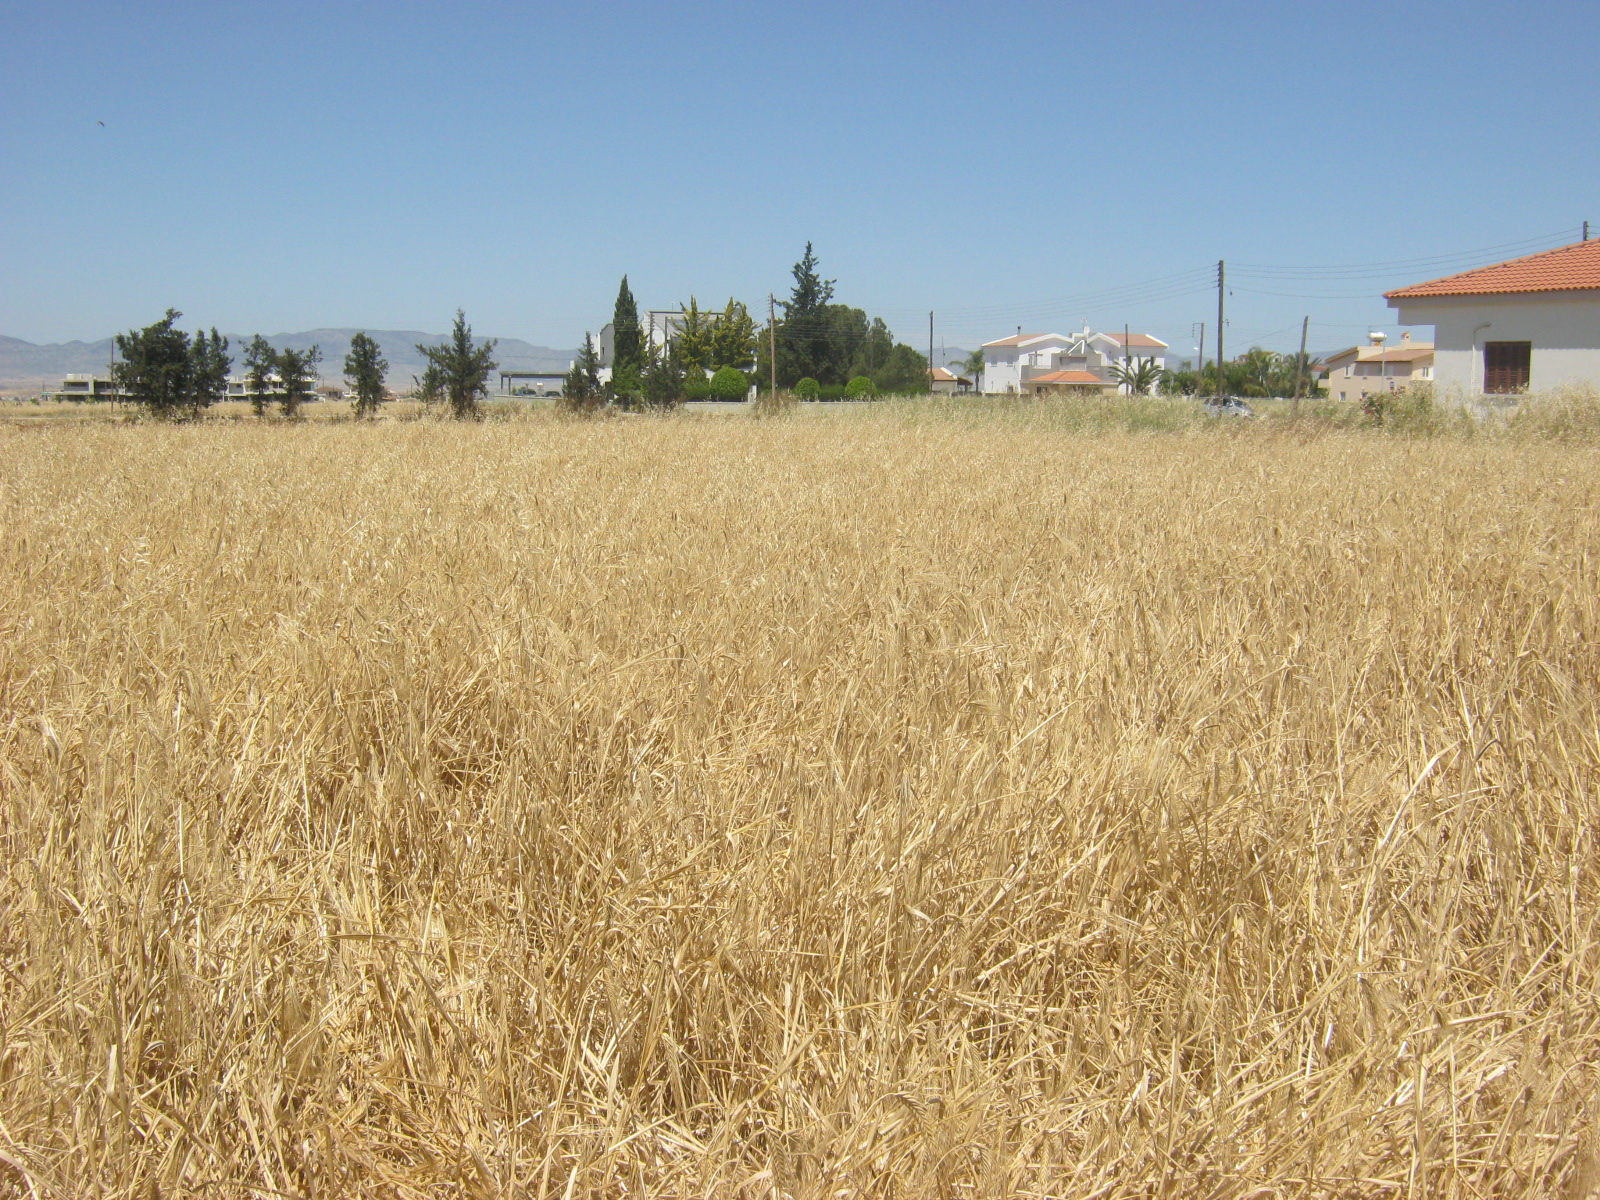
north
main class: Cropland
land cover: Barley
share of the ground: > 75 %
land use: Agriculture (excluding fallow land and kitchen gardens)
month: May
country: CY
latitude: 35.1136
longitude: 33.2163
